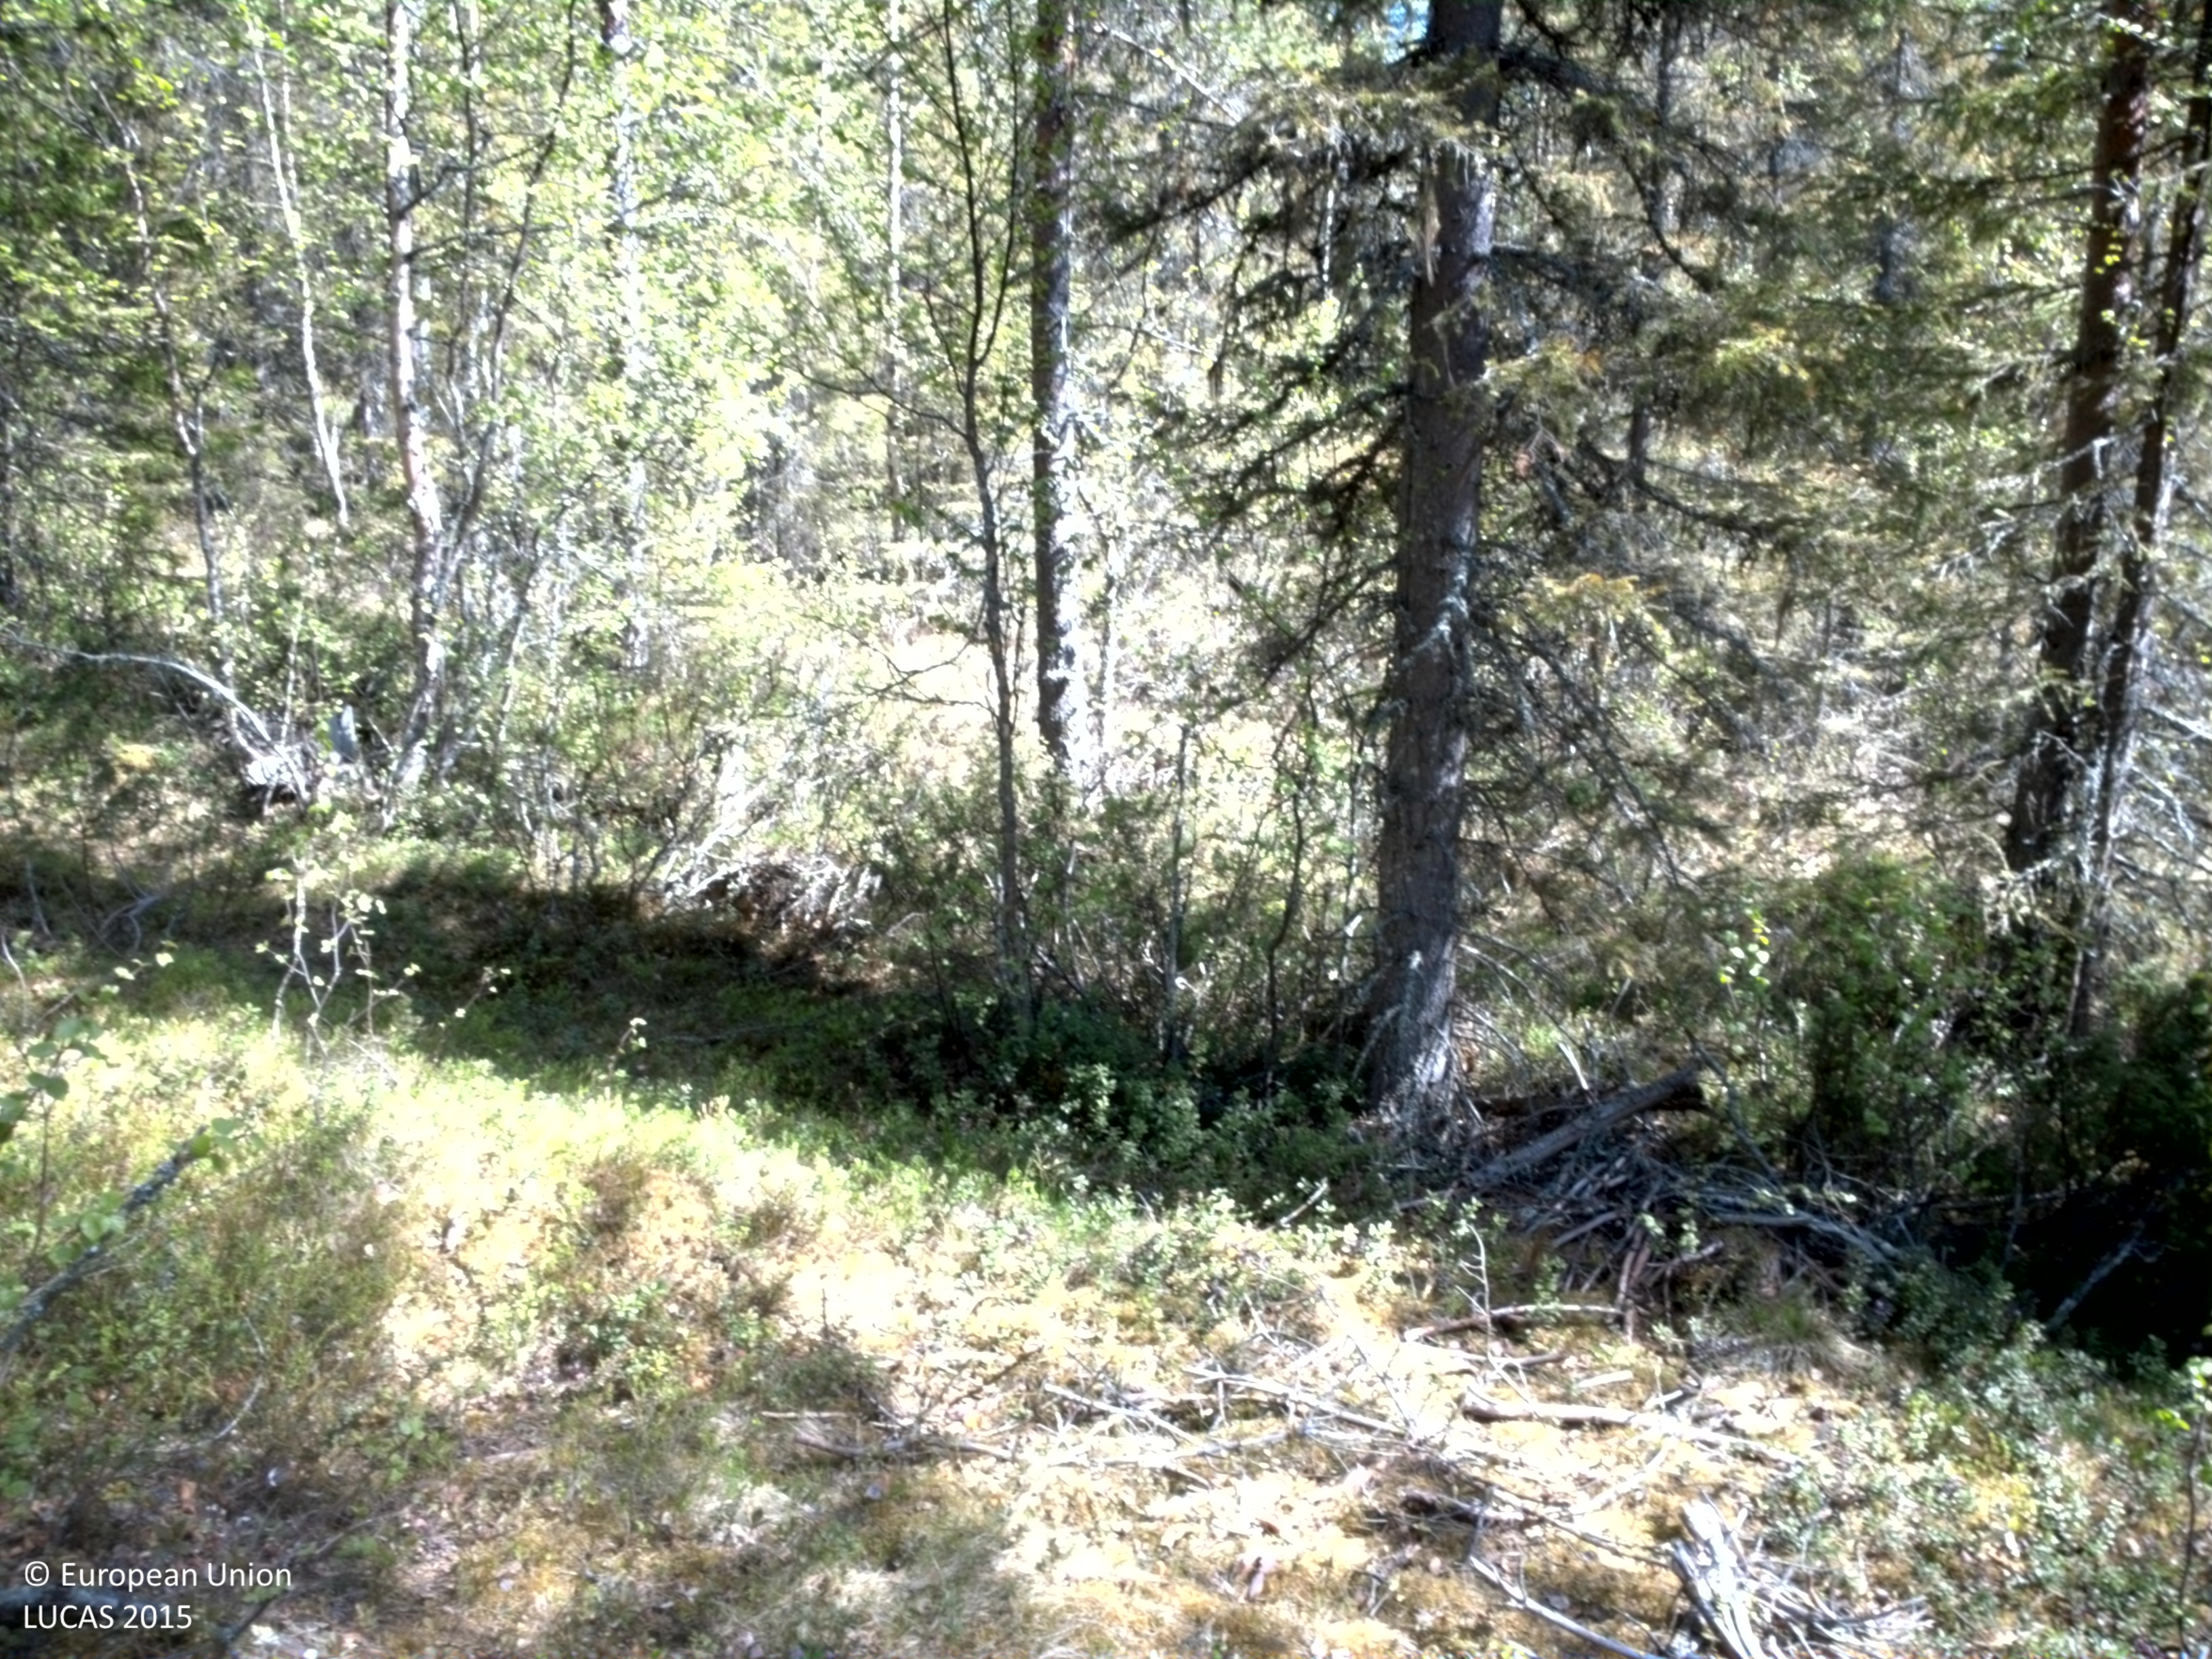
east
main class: Woodland
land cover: Pine dominated mixed woodland
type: boreal forest
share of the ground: 50 - 75 %
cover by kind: coniferous forest trees 45 %, shrubs 35 %, broadleaved forest trees 20 %
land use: Forestry
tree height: > 5 m
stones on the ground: 10 - 25 %
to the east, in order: Pine dominated mixed woodland; Spruce dominated mixed woodland; Rivers and streams; Spruce dominated coniferous woodland; Pine dominated coniferous woodland; Spruce dominated mixed woodland; Rivers and streams; Spruce dominated mixed woodland; Rivers and streams; Shrubland with sparse tree cover; Pine dominated coniferous woodland
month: June
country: SE
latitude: 65.8069
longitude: 18.8582
